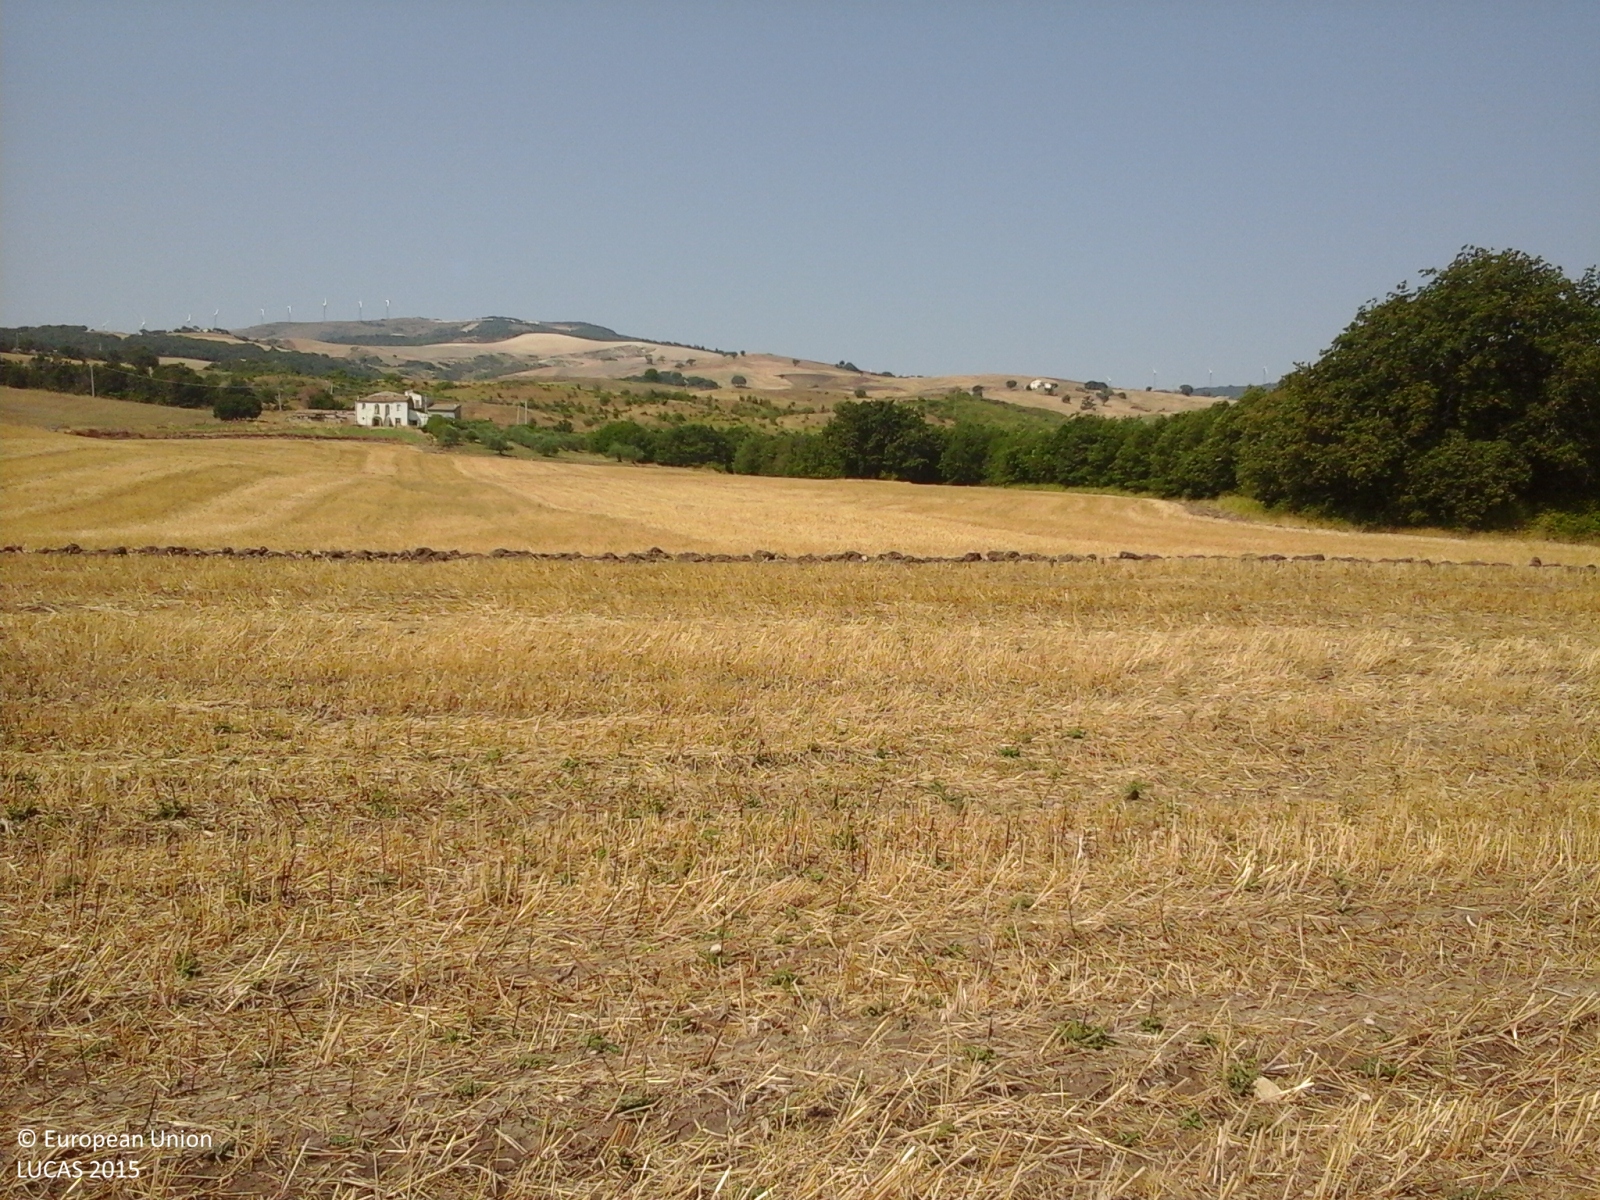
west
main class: Cropland
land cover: Common wheat
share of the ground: > 75 %
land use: Agriculture (excluding fallow land and kitchen gardens)
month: August
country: IT
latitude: 41.4361
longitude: 15.1644
